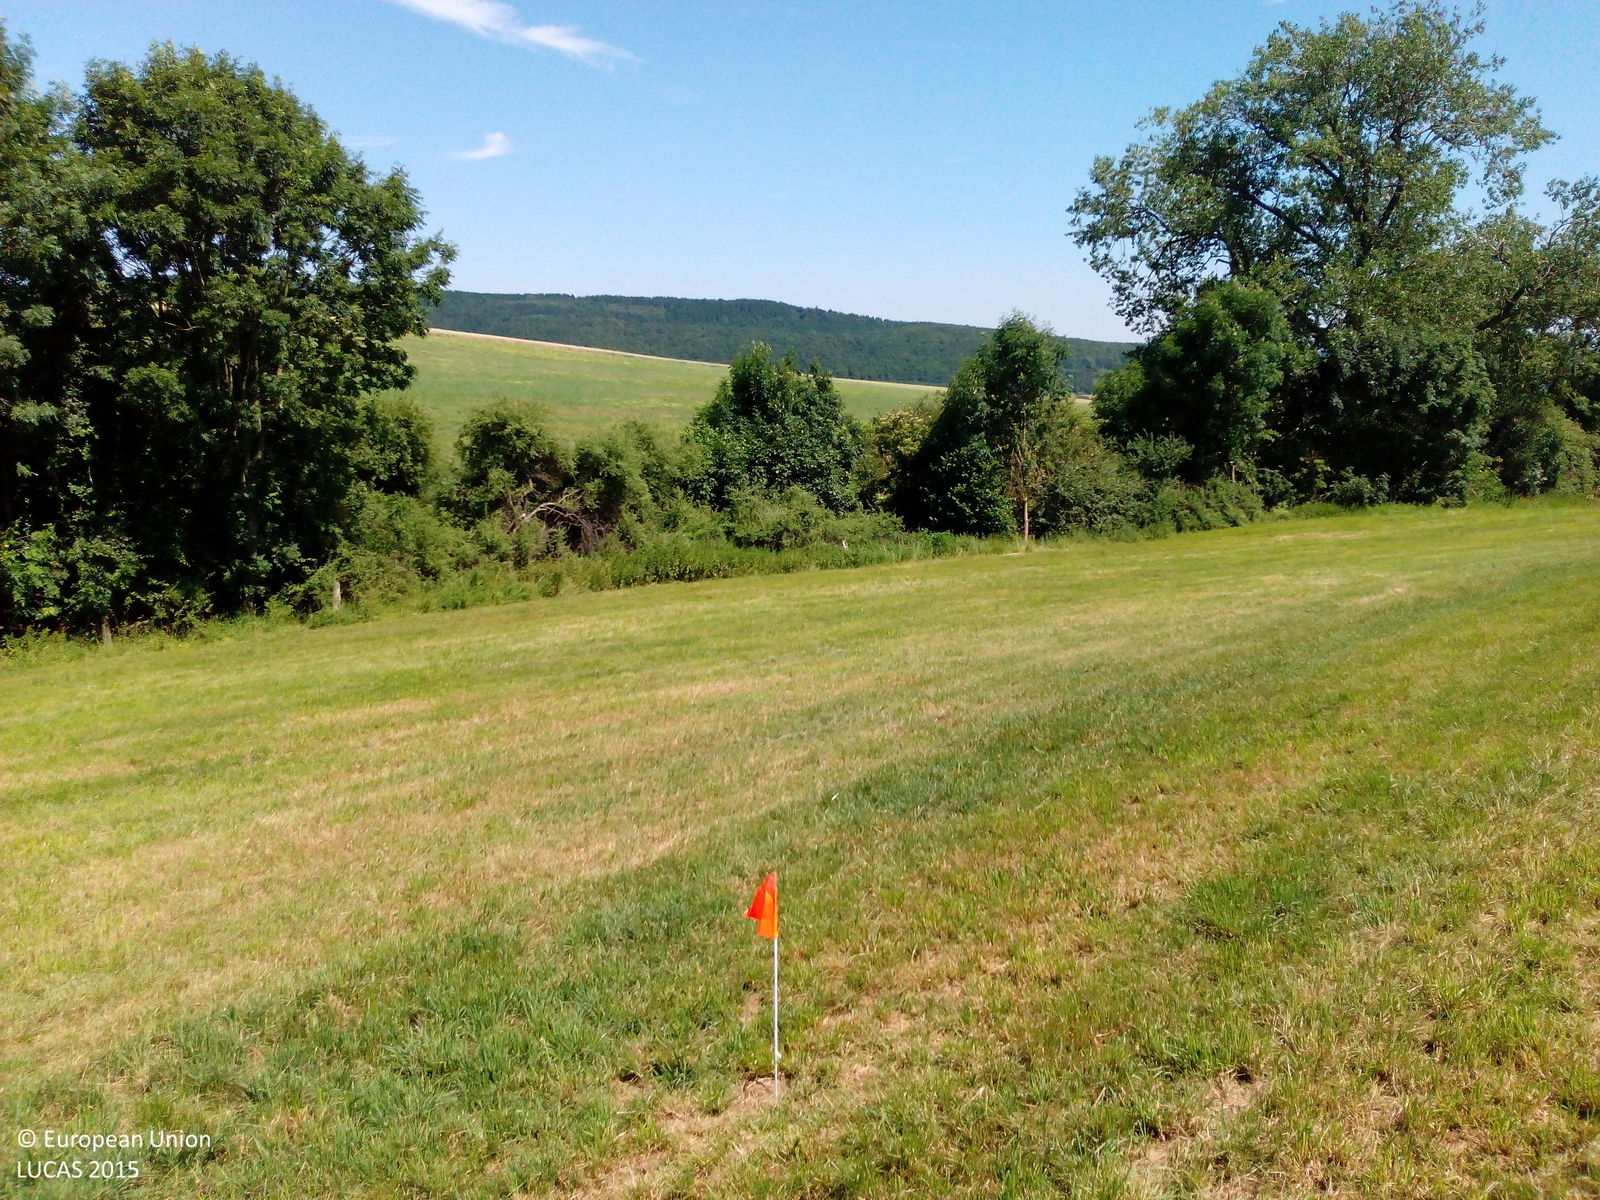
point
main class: Grassland
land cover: Grassland without tree/shrub cover
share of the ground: > 75 %
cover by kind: herbaceous plants 100 %
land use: Agriculture (excluding fallow land and kitchen gardens)
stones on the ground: < 10 %
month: July
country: DE
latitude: 51.7123
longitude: 9.8408
